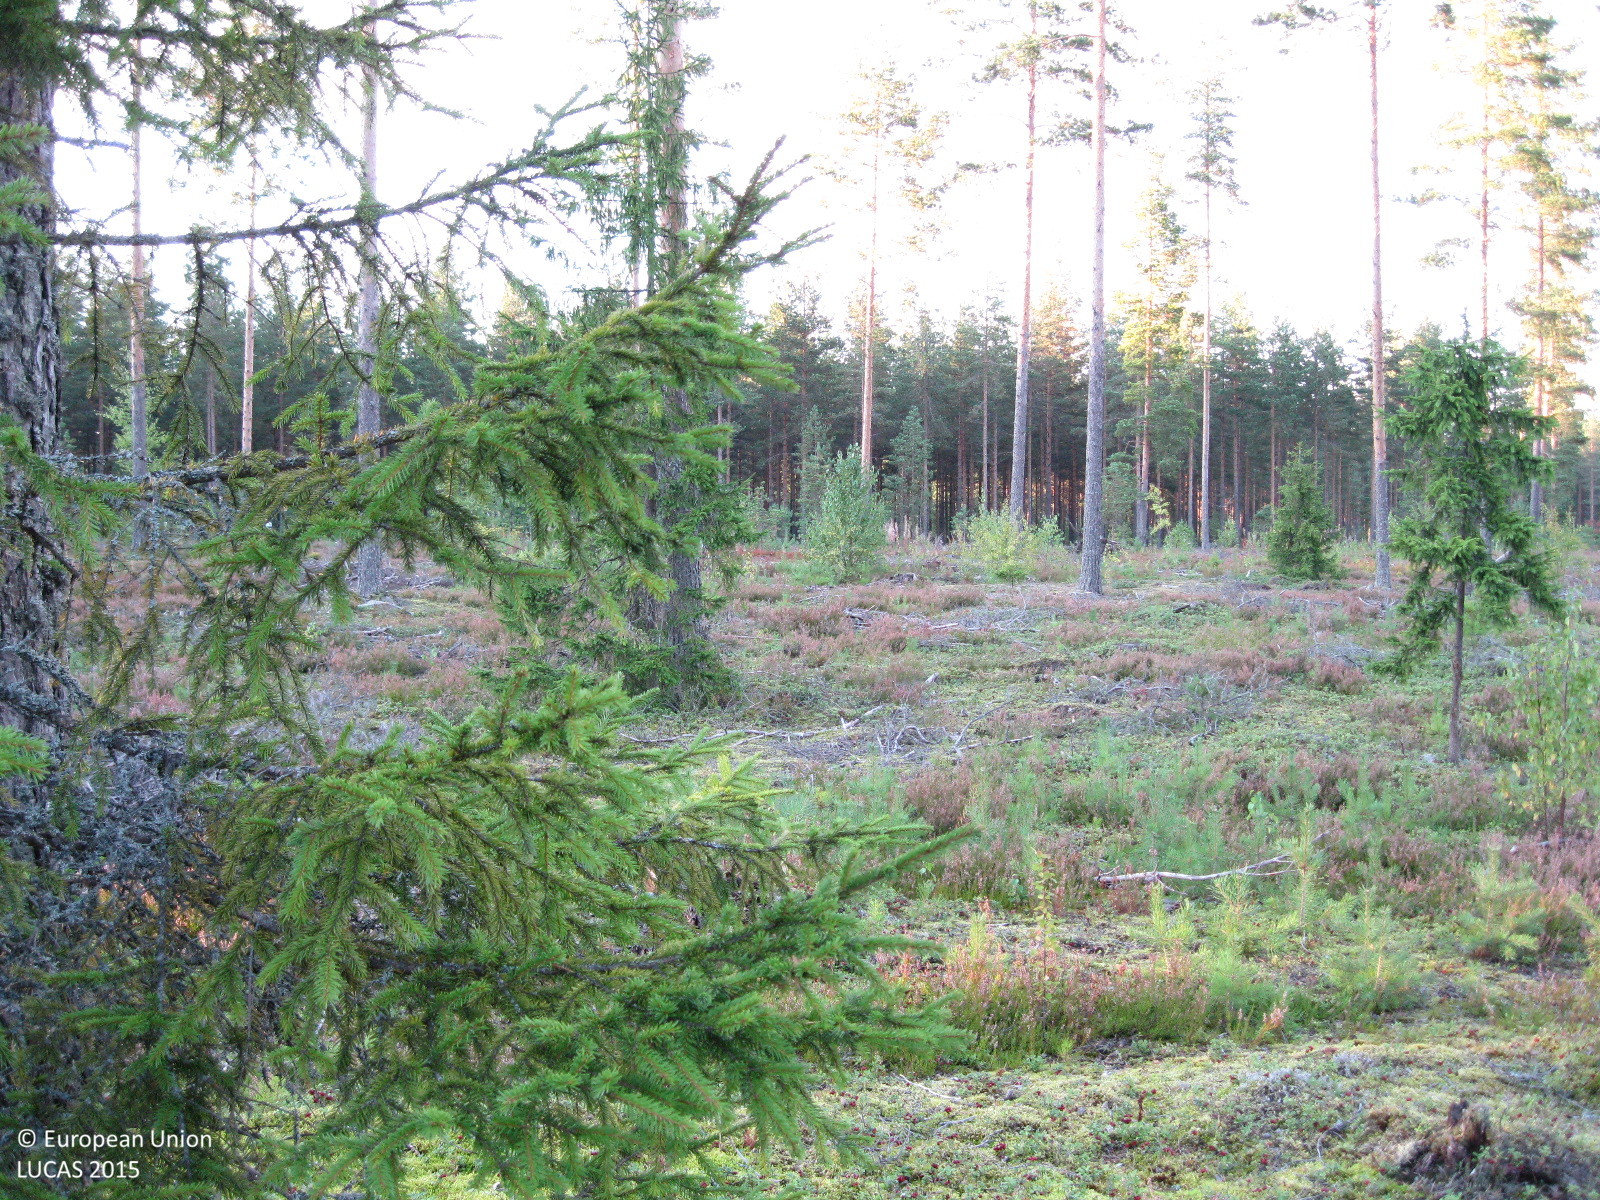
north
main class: Woodland
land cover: Pine dominated coniferous woodland
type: boreal forest
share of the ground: 25 - 50 %
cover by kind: shrubs 45 %, coniferous forest trees 25 %, lichens and mosses 25 %, broadleaved forest trees 5 %
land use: Forestry
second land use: Amenities, museums, leisure
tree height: > 5 m
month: September
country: FI
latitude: 60.5066
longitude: 24.6961
